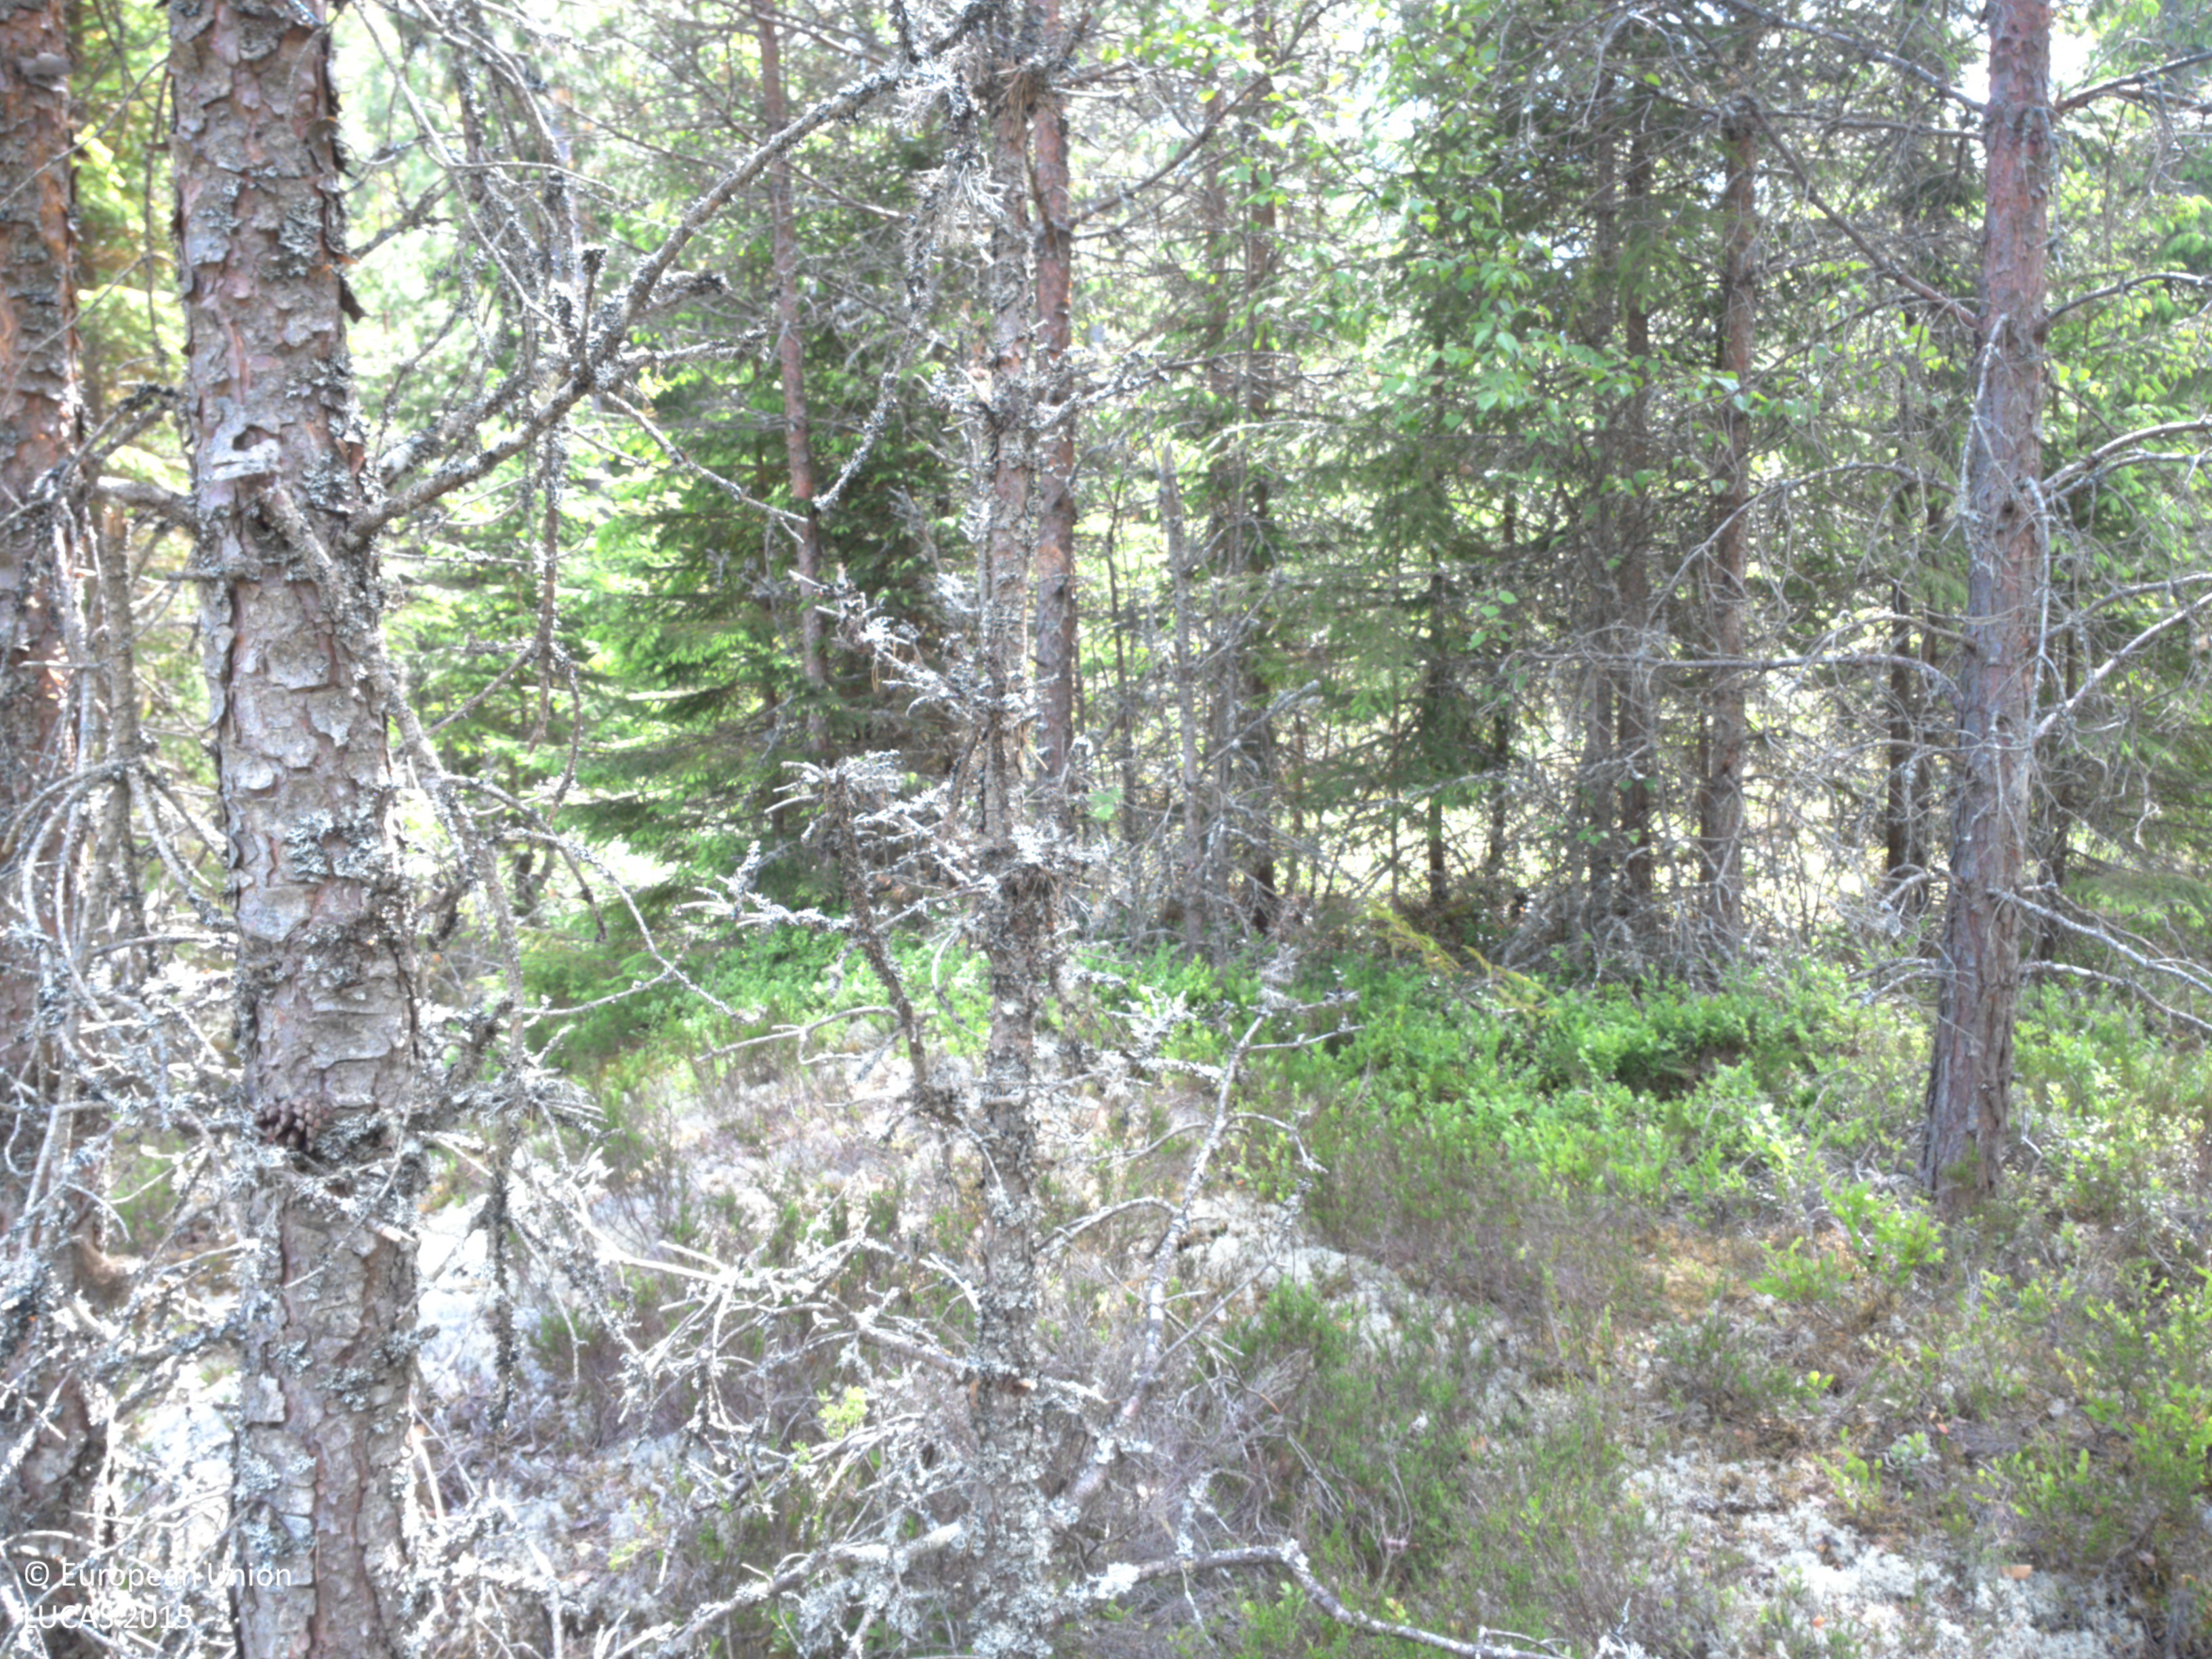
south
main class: Woodland
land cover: Pine dominated coniferous woodland
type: boreal forest
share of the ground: 50 - 75 %
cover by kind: coniferous forest trees 50 %, lichens and mosses 30 %, shrubs 20 %
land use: Forestry
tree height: > 5 m
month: June
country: SE
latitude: 59.1179
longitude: 12.2828
